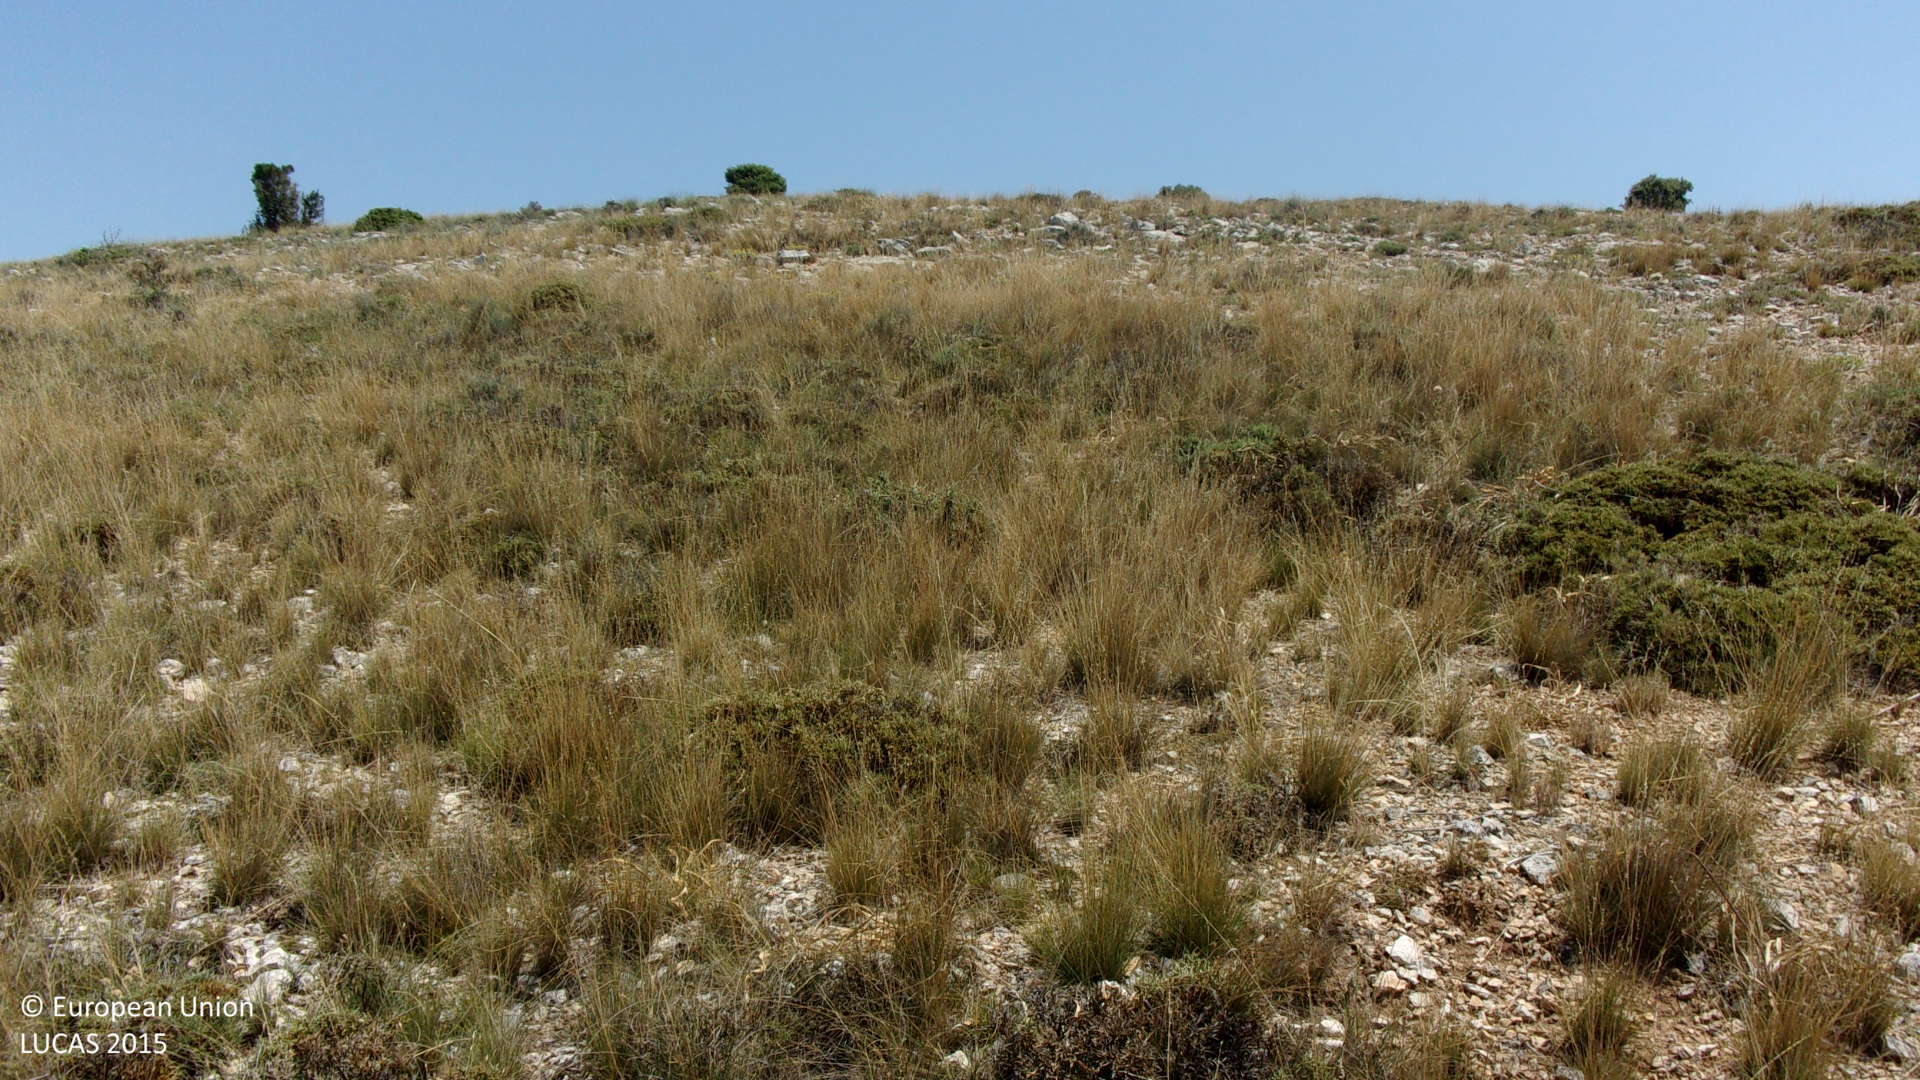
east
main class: Shrubland
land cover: Shrubland without tree cover
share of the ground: > 75 %
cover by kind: shrubs 65 %, consolidated bare surface 20 %, herbaceous plants 15 %
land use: Semi-natural and natural areas not in use
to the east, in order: Shrubland without tree cover
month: July
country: ES
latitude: 41.5830
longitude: -1.9171
